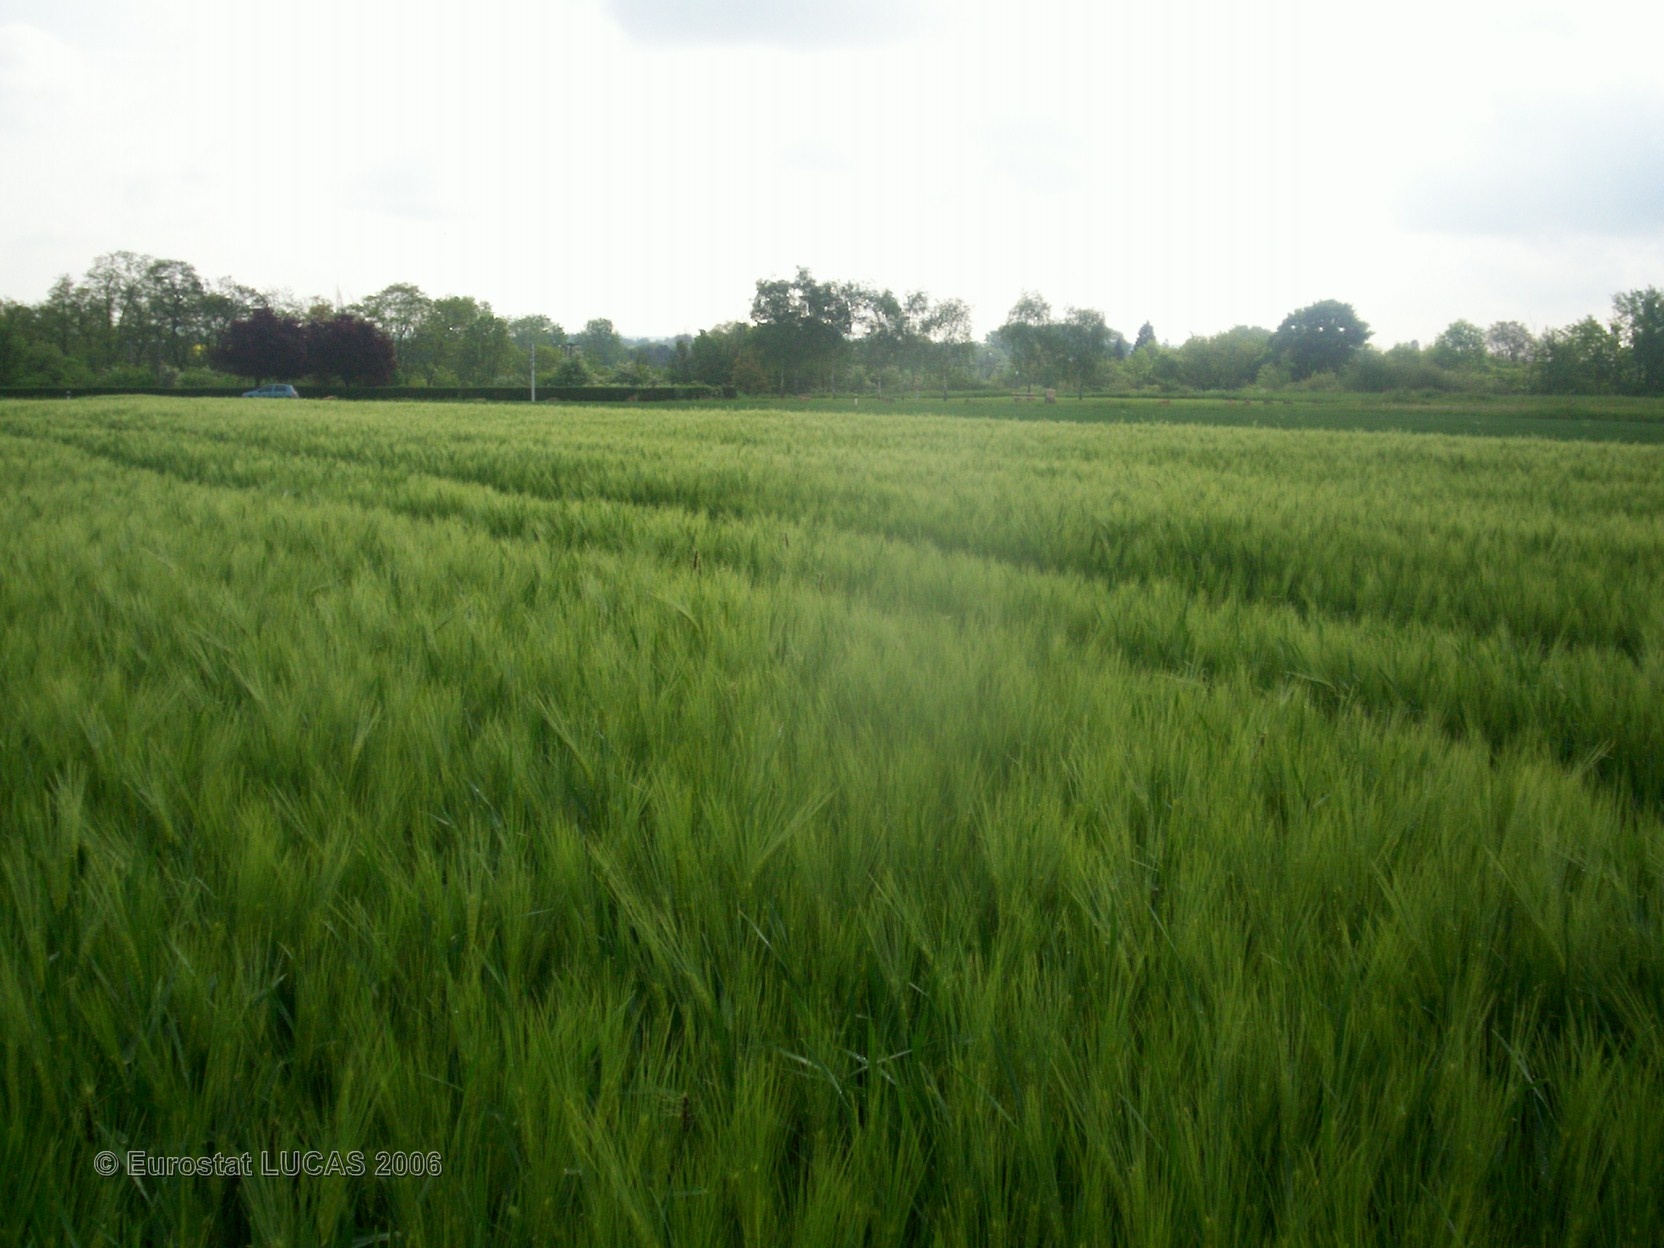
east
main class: Cropland
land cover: Barley
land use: Agriculture (excluding fallow land and kitchen gardens)
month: May
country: FR
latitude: 49.1012
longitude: 5.8766
